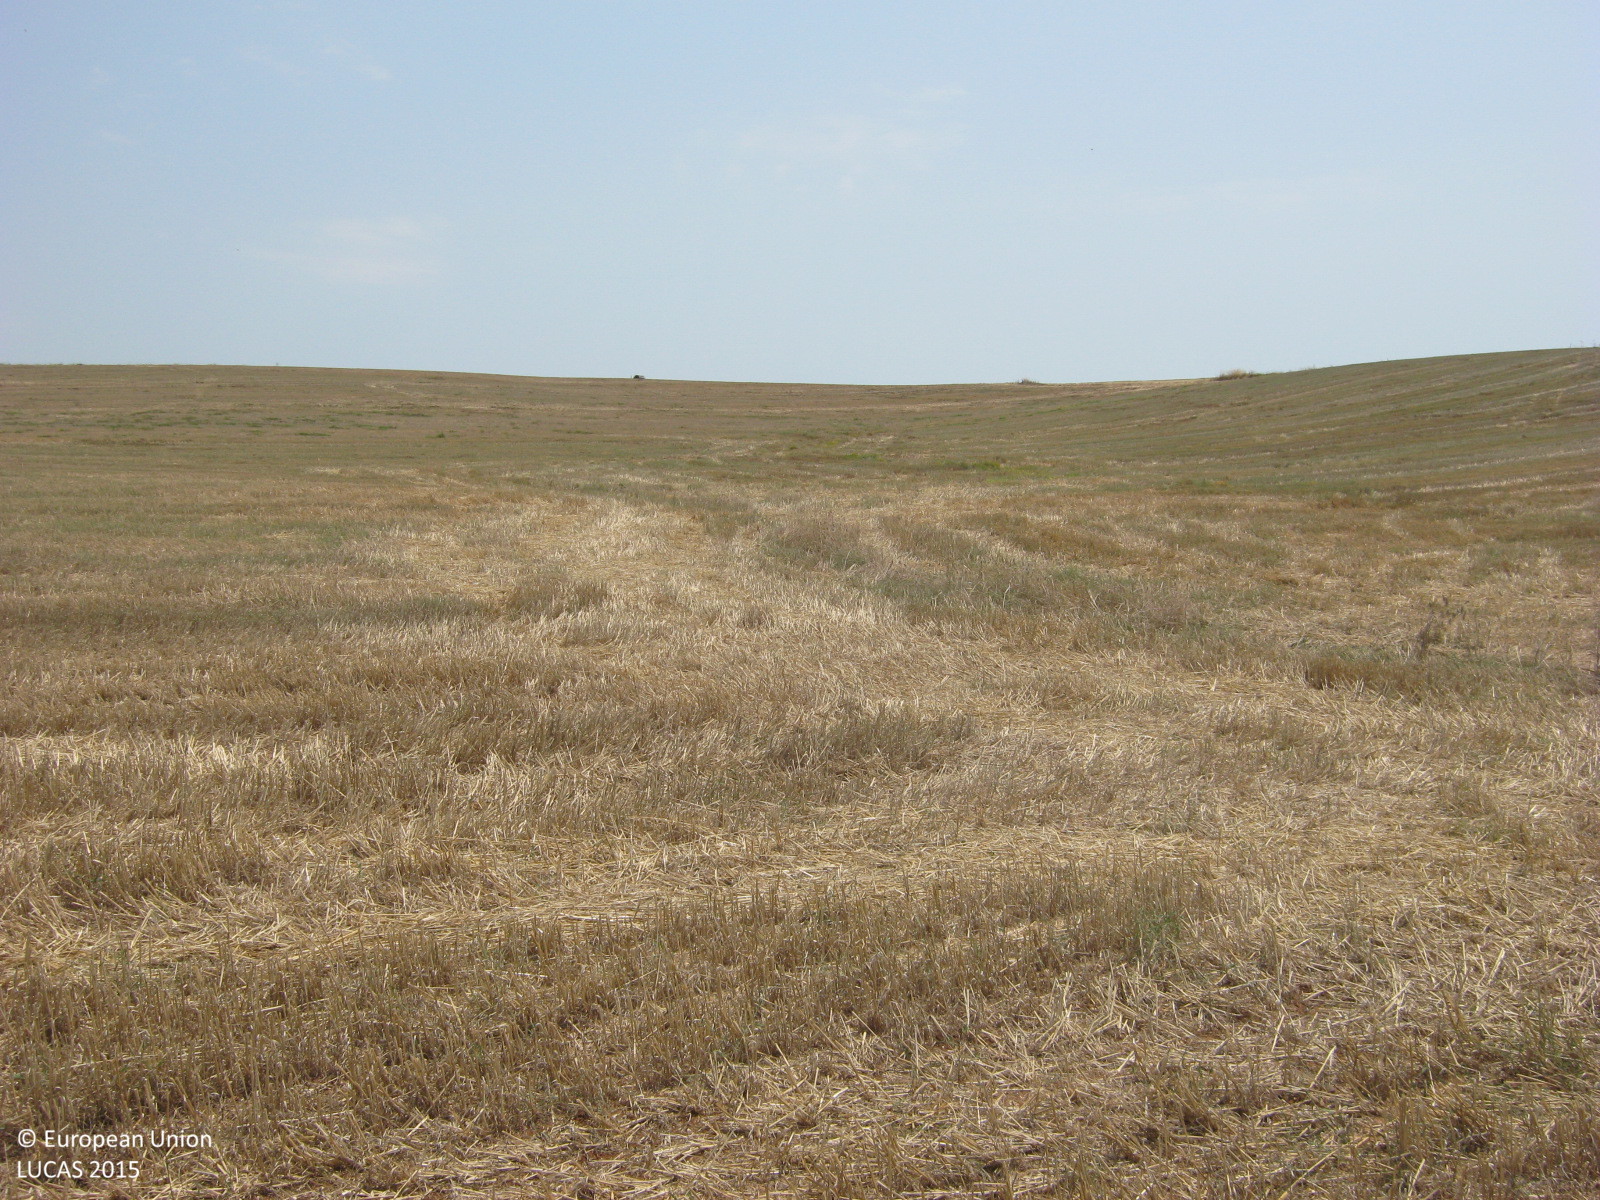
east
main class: Cropland
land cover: Durum wheat
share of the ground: > 75 %
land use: Agriculture (excluding fallow land and kitchen gardens)
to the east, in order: Durum wheat; Spontaneously vegetated surfaces; Durum wheat
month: July
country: GR
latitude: 40.2539
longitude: 23.3039
